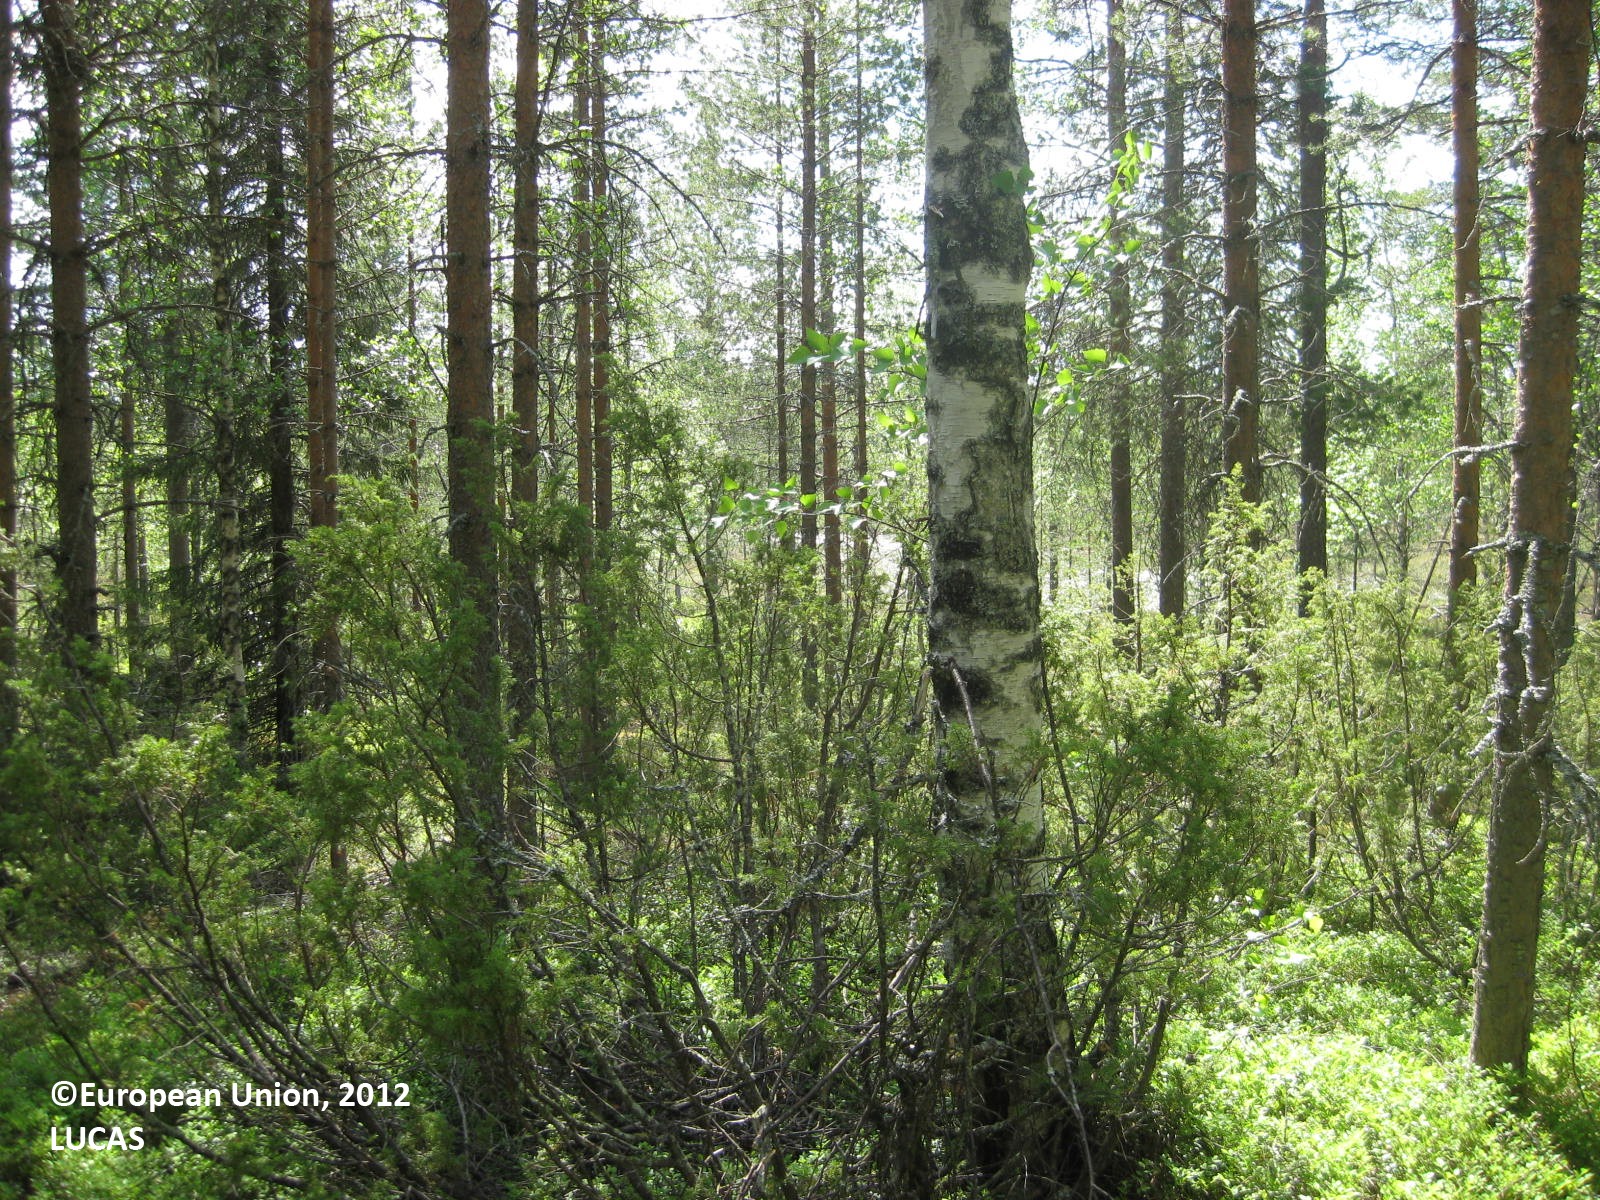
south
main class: Woodland
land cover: Pine dominated mixed woodland
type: boreal forest
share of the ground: > 75 %
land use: Forestry
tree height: > 5 m
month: June
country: FI
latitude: 65.0146
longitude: 28.9635
